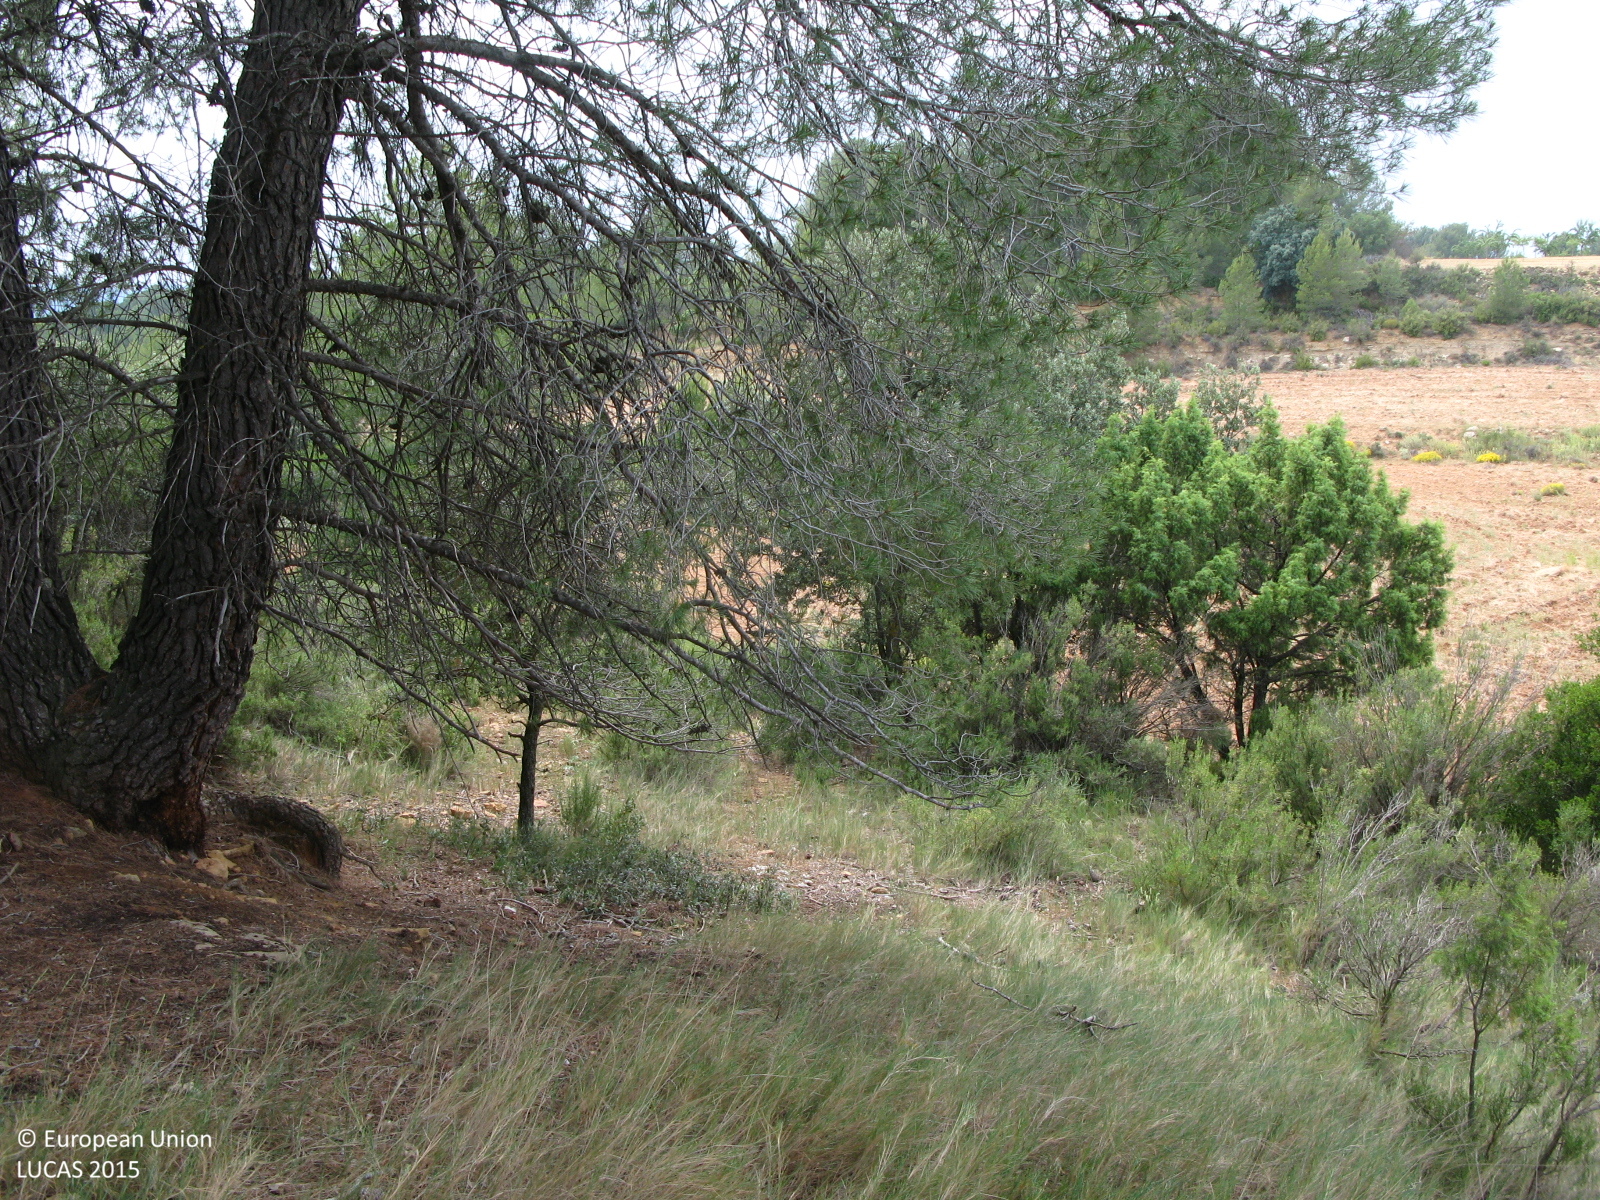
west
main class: Woodland
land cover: Pine dominated coniferous woodland
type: coniferous forest of the mediterranean region
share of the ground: 25 - 50 %
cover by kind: shrubs 40 %, herbaceous plants 30 %, coniferous forest trees 25 %, broadleaved forest trees 5 %
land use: Forestry
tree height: > 5 m
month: June
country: ES
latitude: 39.8320
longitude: -0.9762
